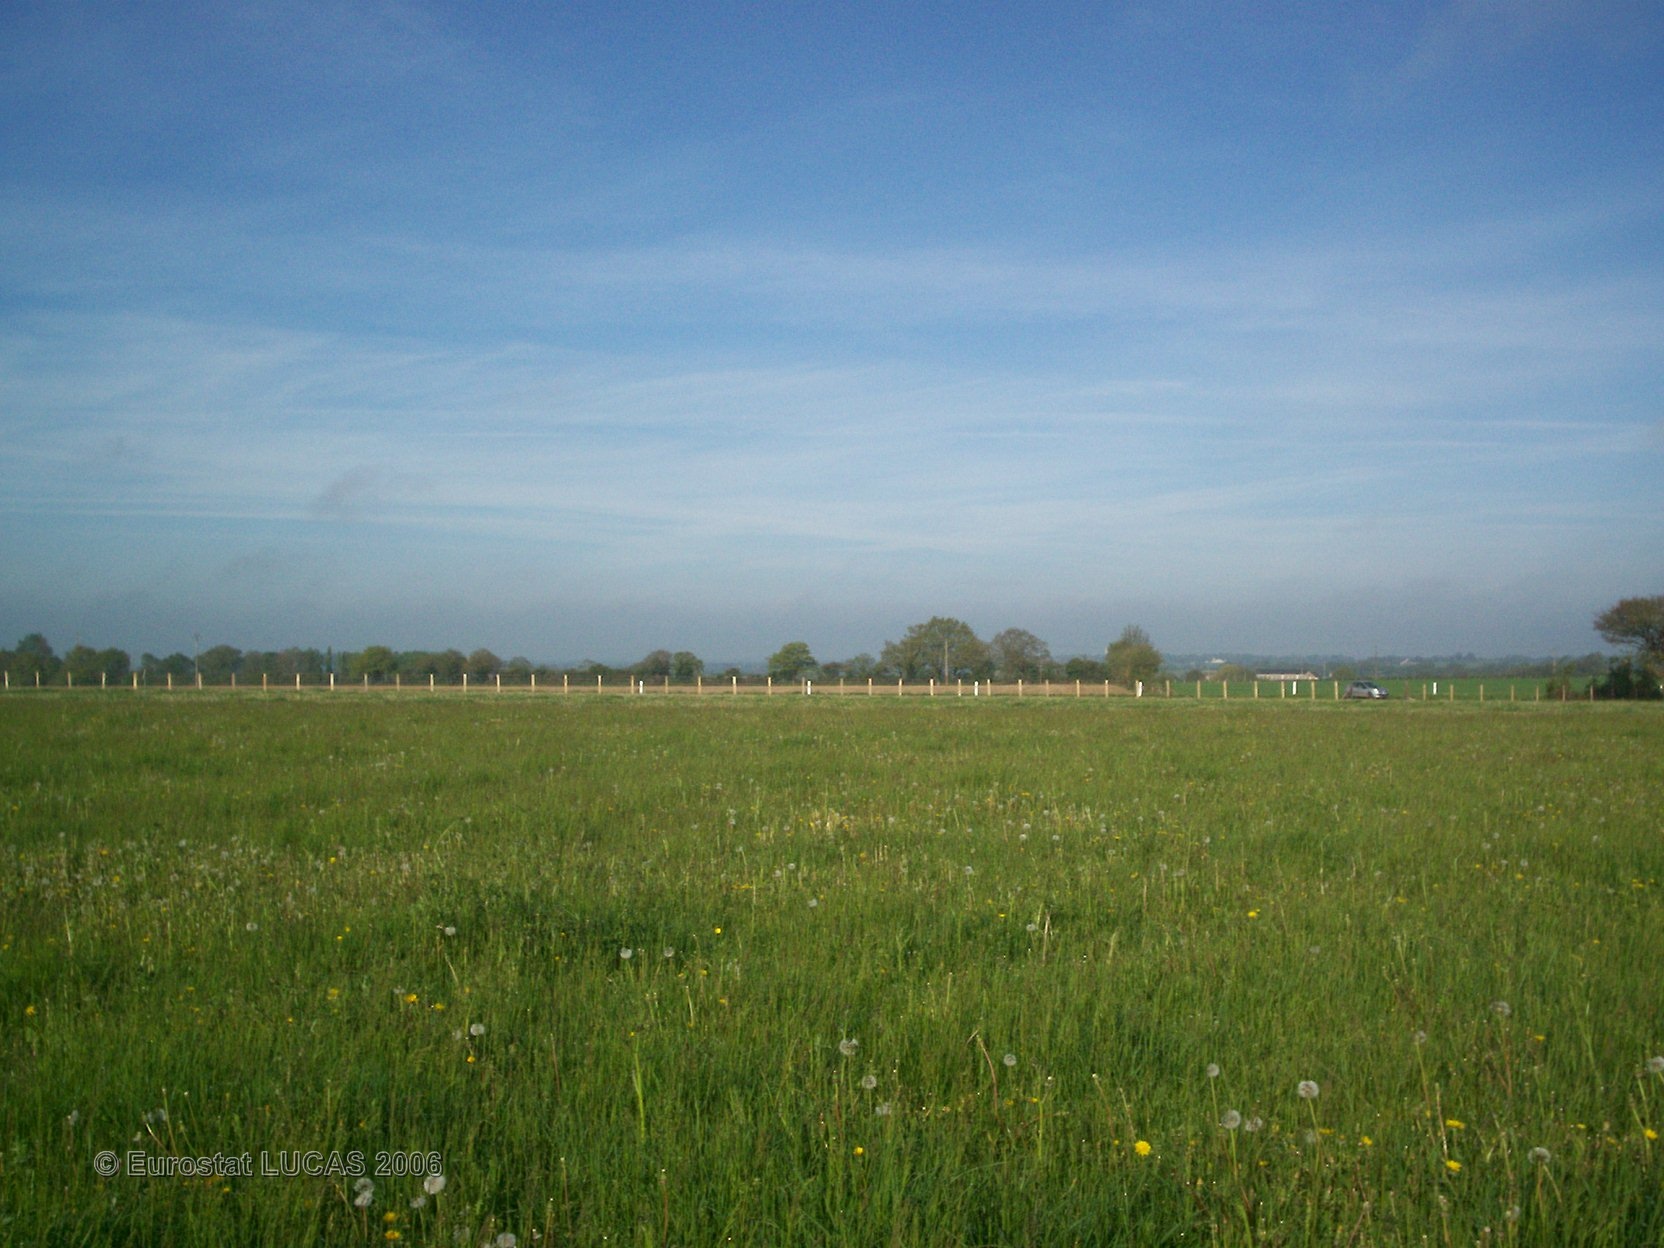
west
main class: Grassland
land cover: Grassland without tree/shrub cover
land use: Agriculture (excluding fallow land and kitchen gardens)
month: May
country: FR
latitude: 48.0716
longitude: -0.6240
